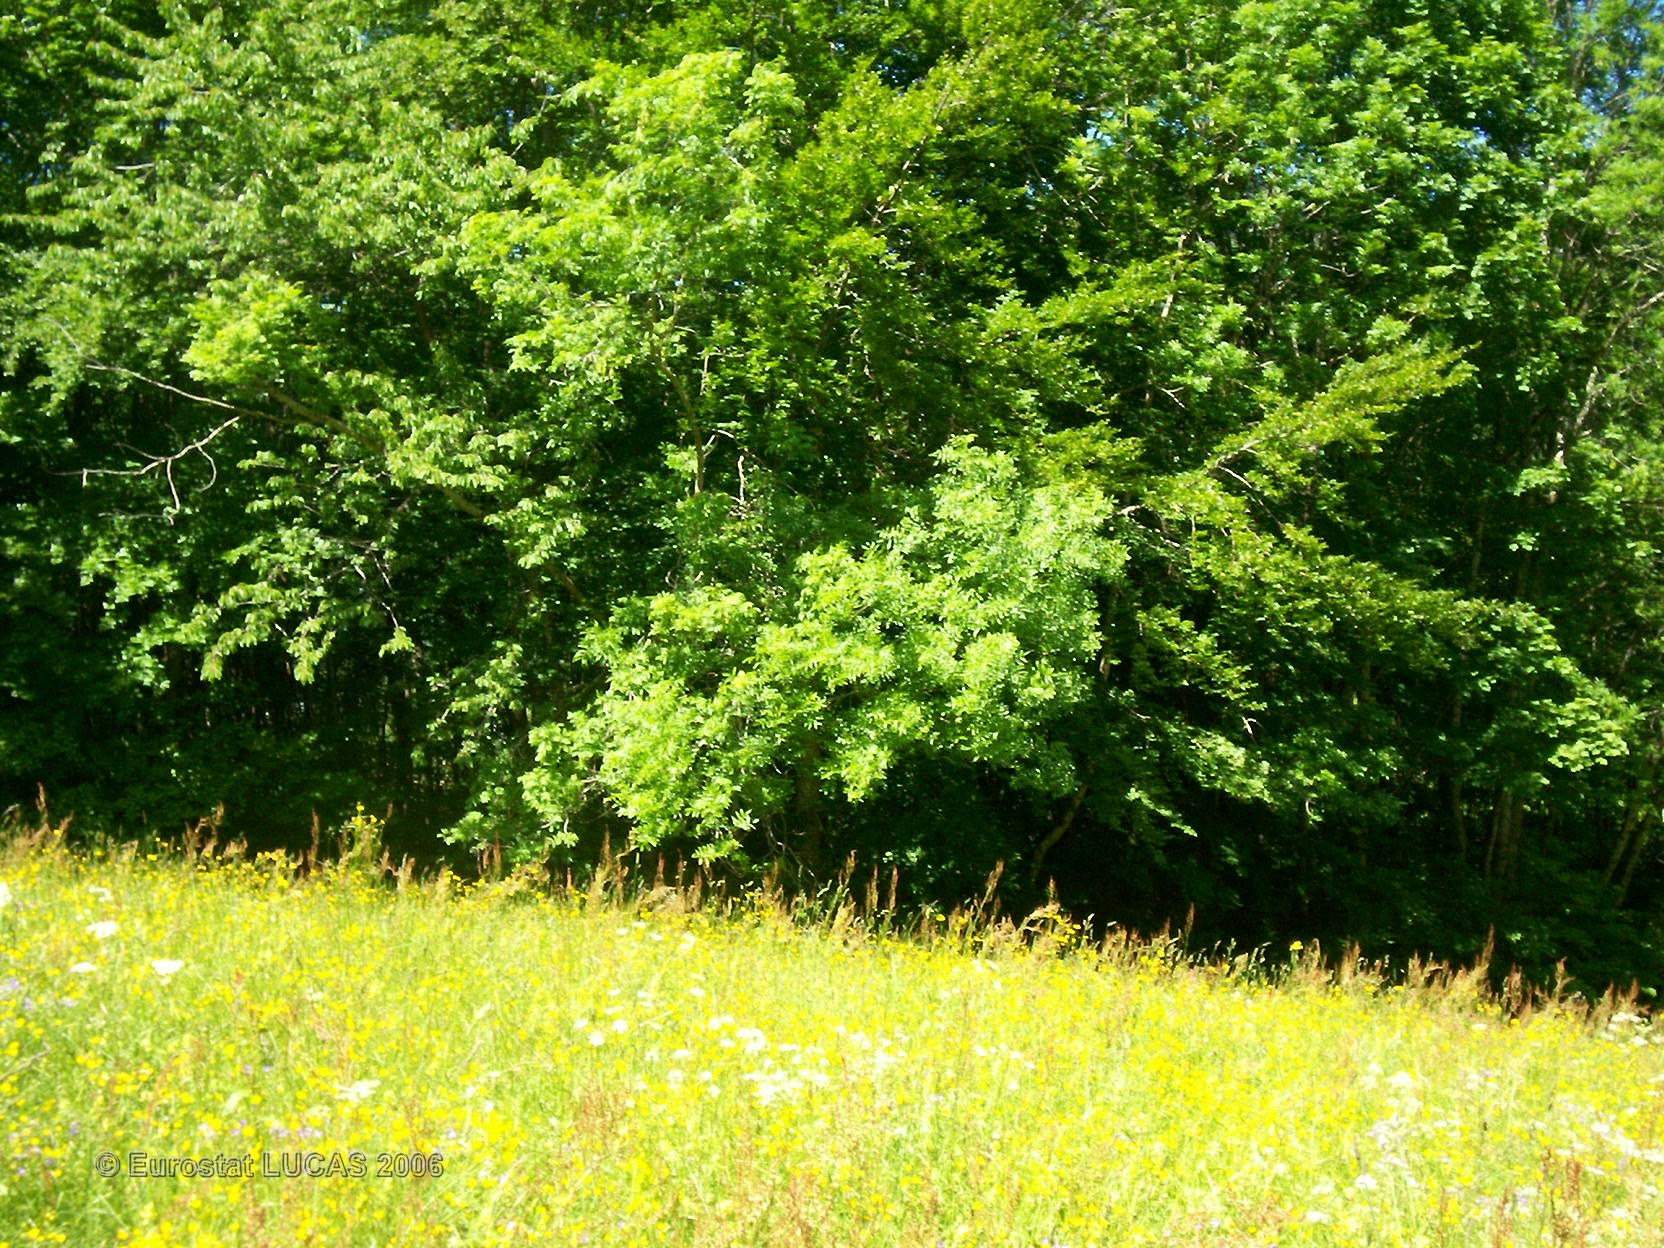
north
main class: Grassland
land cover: Grassland without tree/shrub cover
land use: Agriculture (excluding fallow land and kitchen gardens)
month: June
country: FR
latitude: 46.3173
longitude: 6.6656
